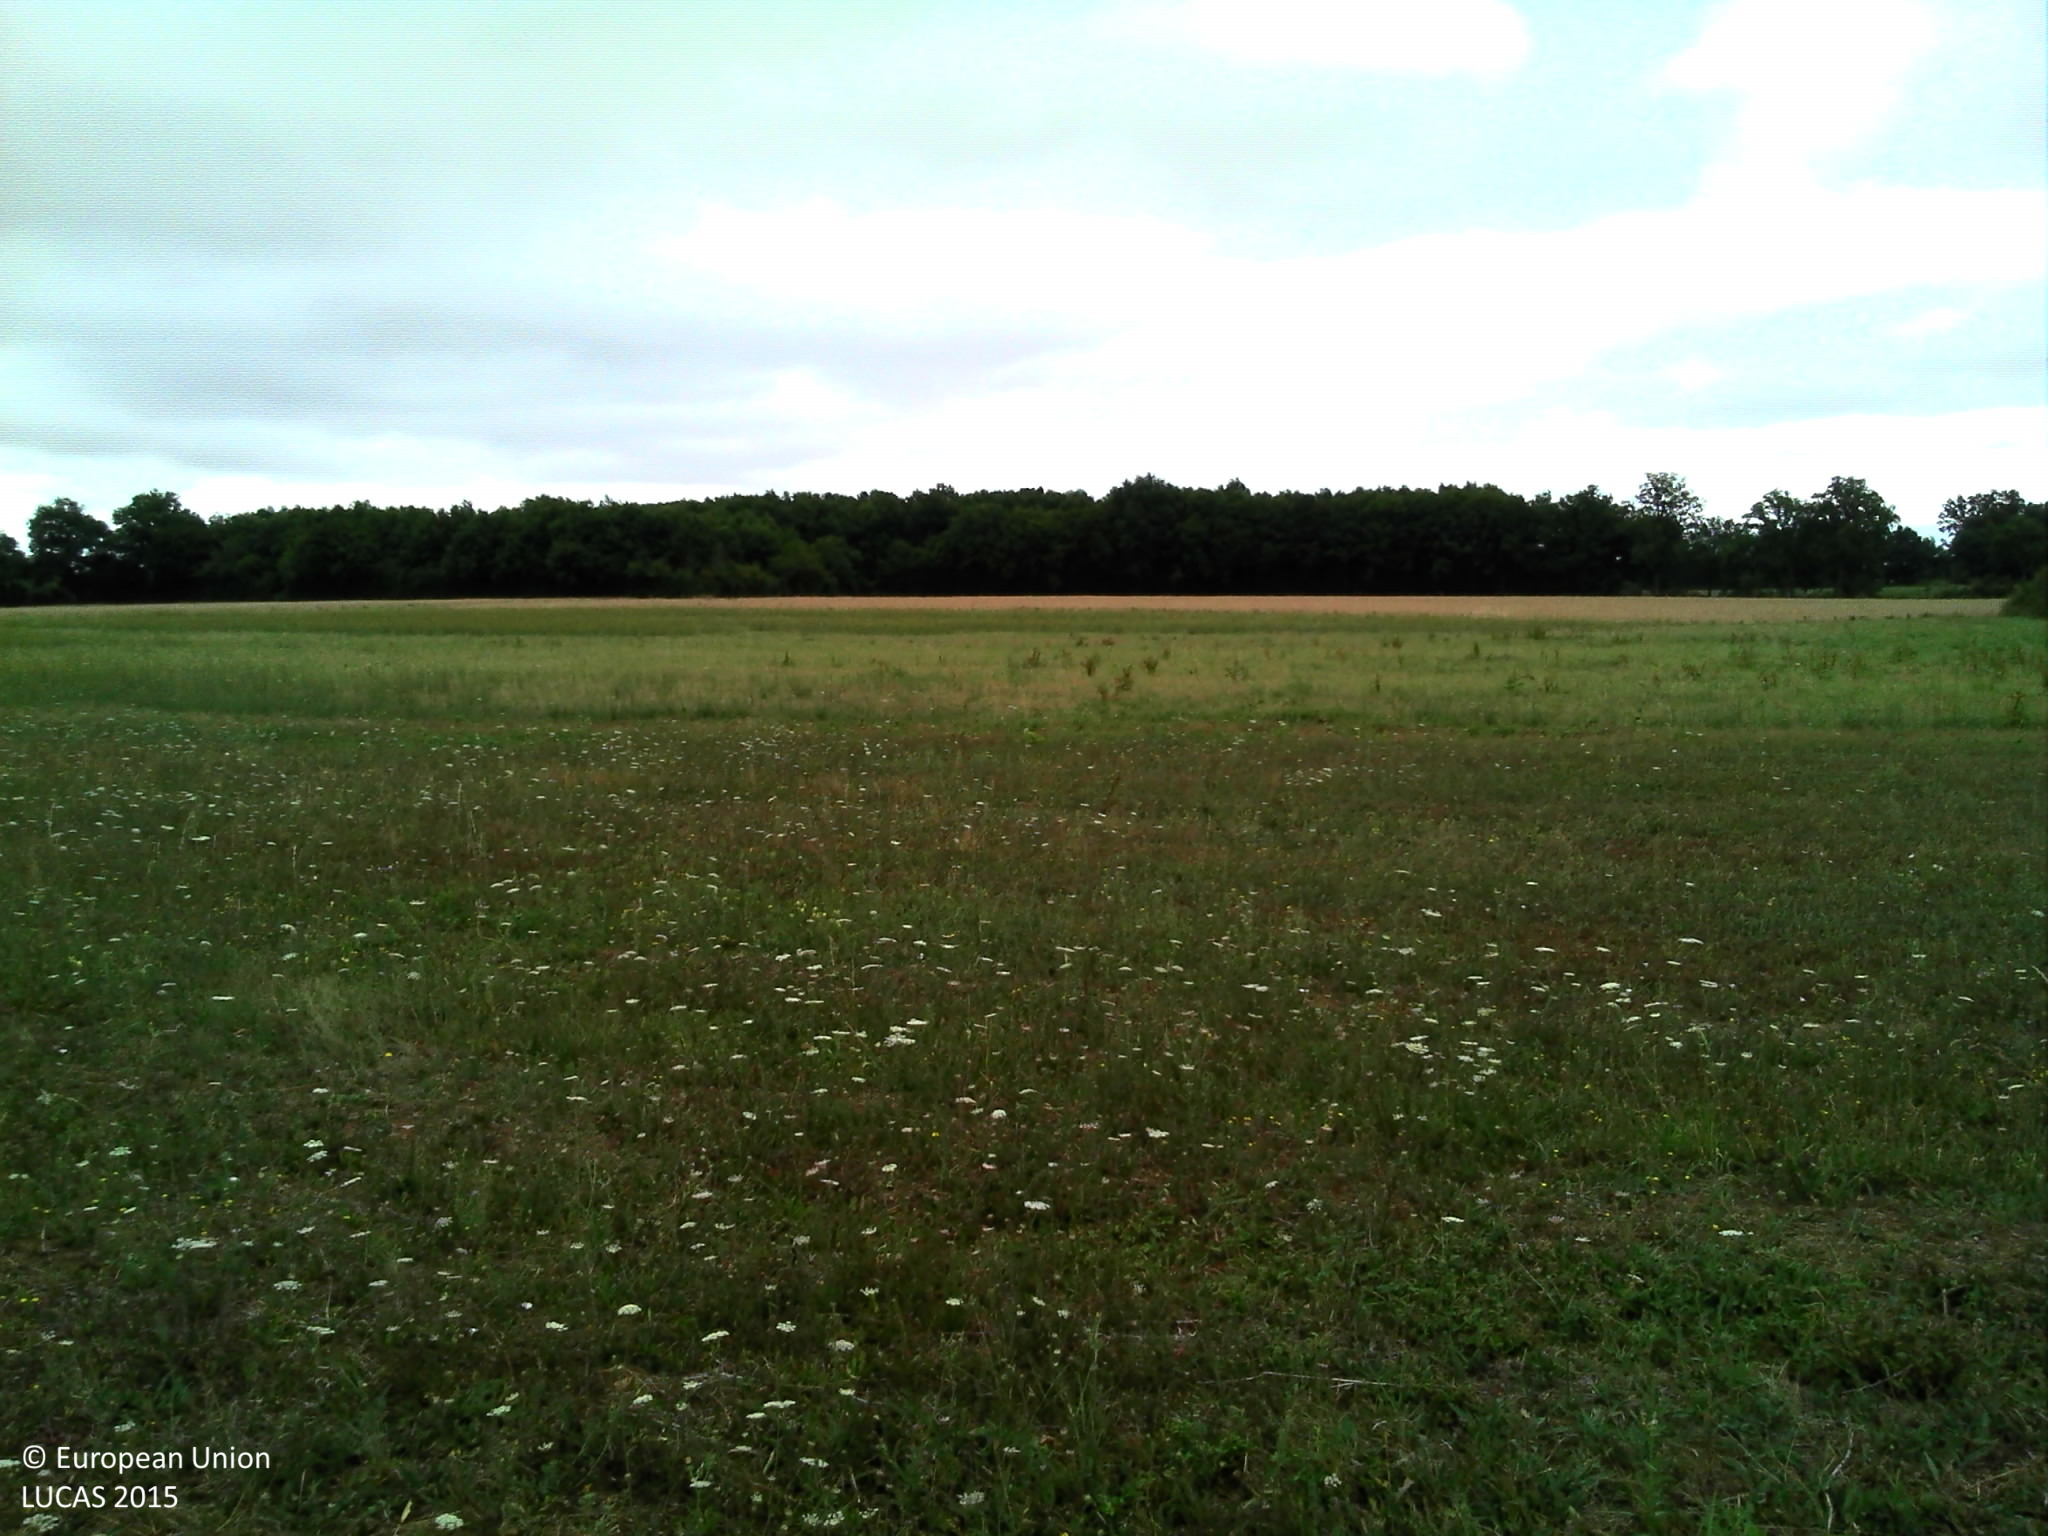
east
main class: Grassland
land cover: Grassland without tree/shrub cover
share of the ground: > 75 %
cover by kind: herbaceous plants 100 %
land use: Agriculture (excluding fallow land and kitchen gardens)
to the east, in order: Grassland without tree/shrub cover; Rape and turnip rape
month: July
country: FR
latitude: 46.2430
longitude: 0.5816
